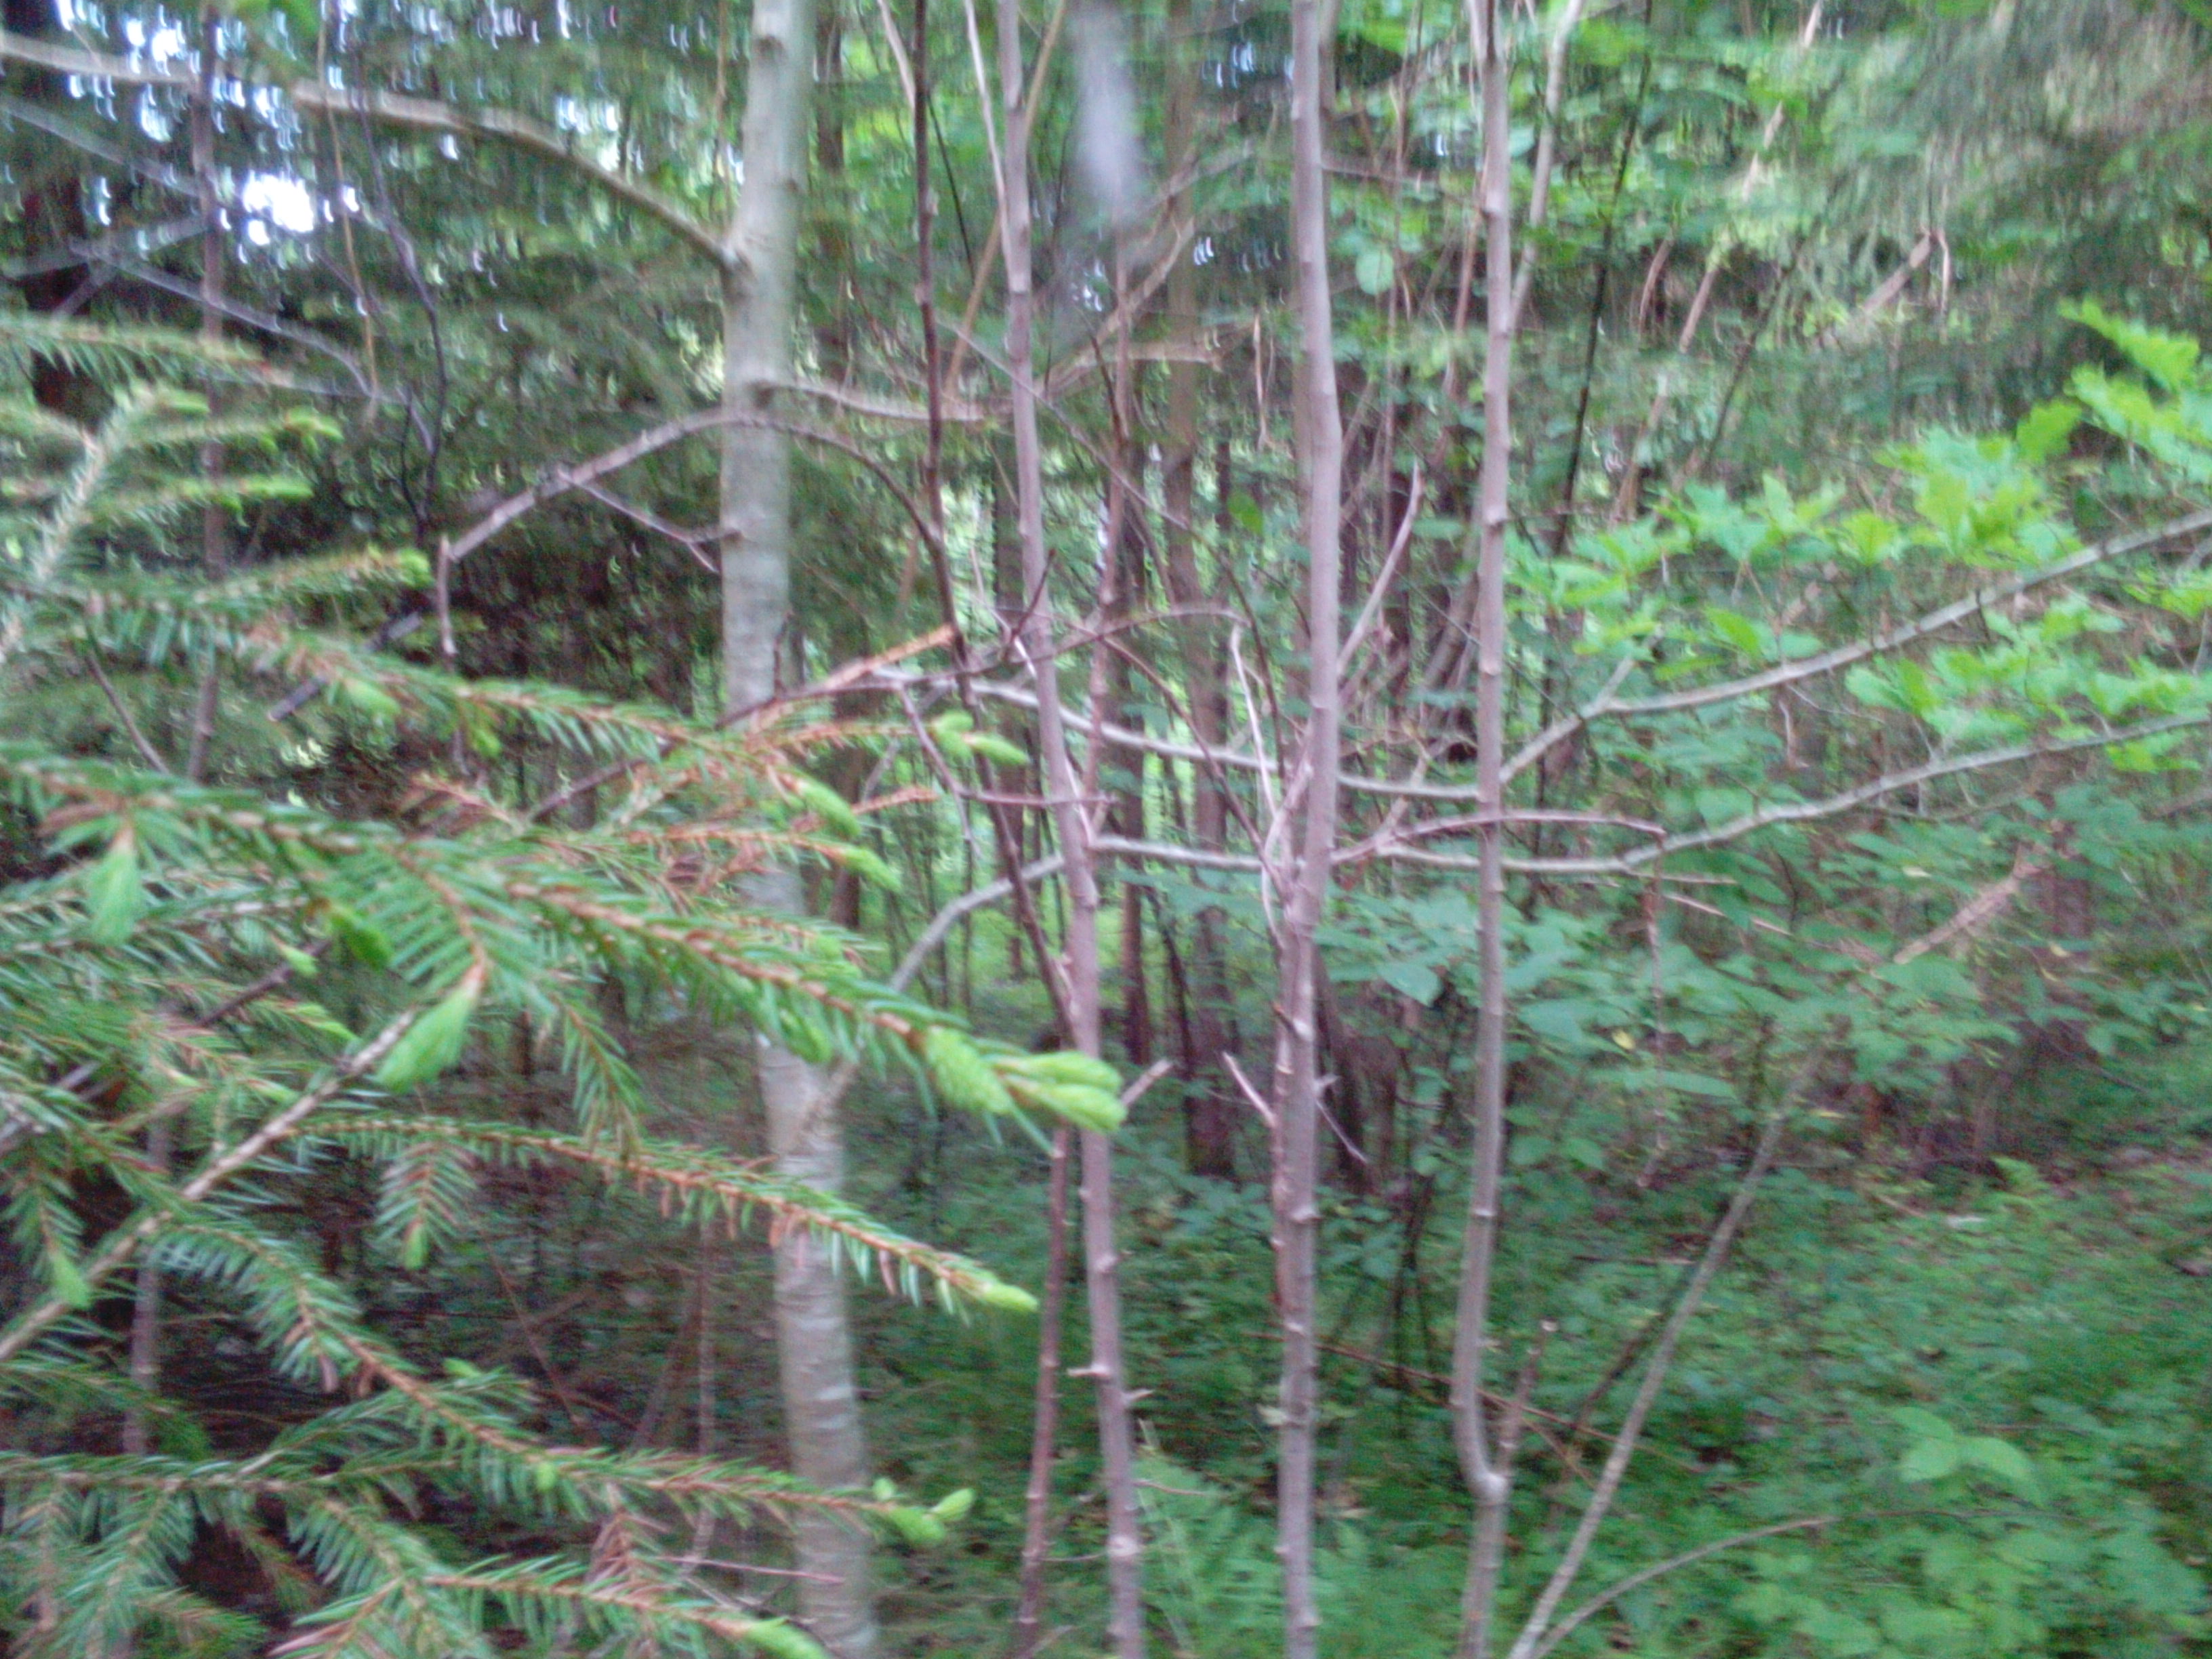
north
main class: Woodland
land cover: Spruce dominated mixed woodland
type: hemiboreal forest and nemoral coniferous forest and mixed broadleaved-coniferous forest
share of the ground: > 75 %
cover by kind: broadleaved forest trees 65 %, coniferous forest trees 35 %
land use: Forestry
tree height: > 5 m
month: June
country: LV
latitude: 56.8530
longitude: 22.2686
